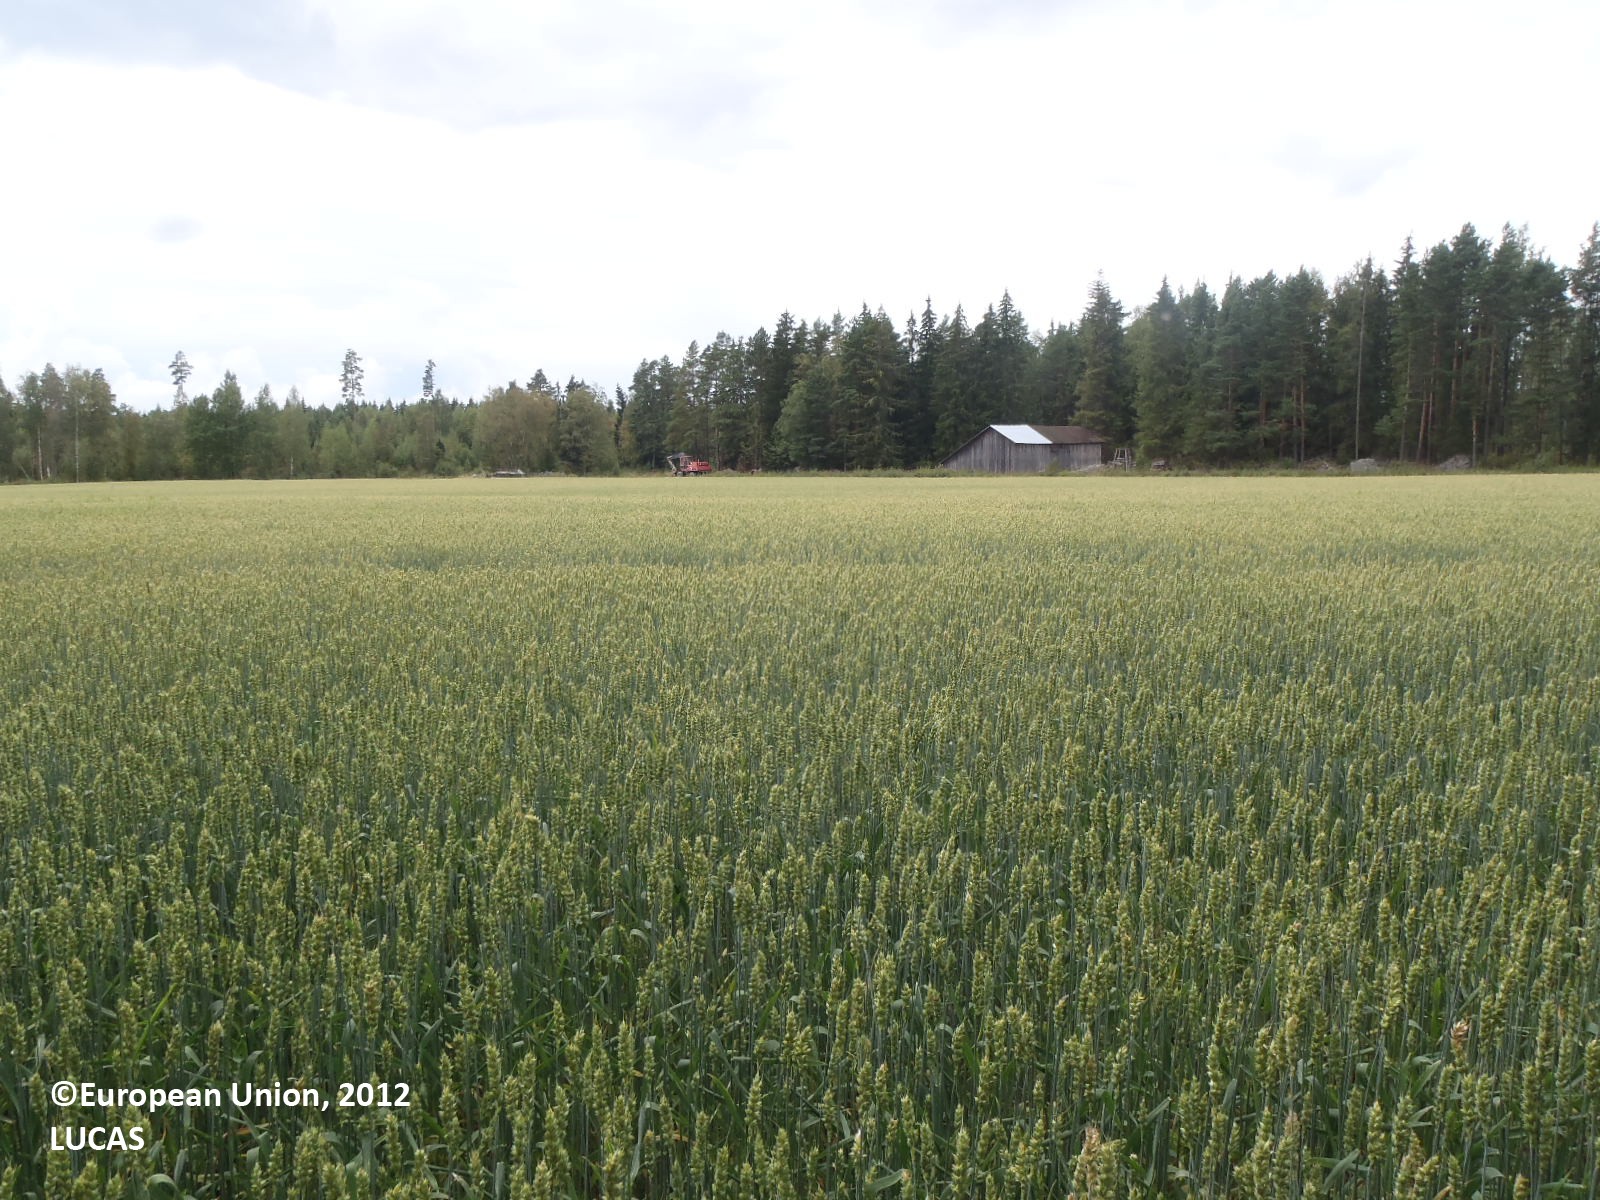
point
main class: Cropland
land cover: Barley
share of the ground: > 75 %
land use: Agriculture (excluding fallow land and kitchen gardens)
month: August
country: FI
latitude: 60.5617
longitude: 22.1951
